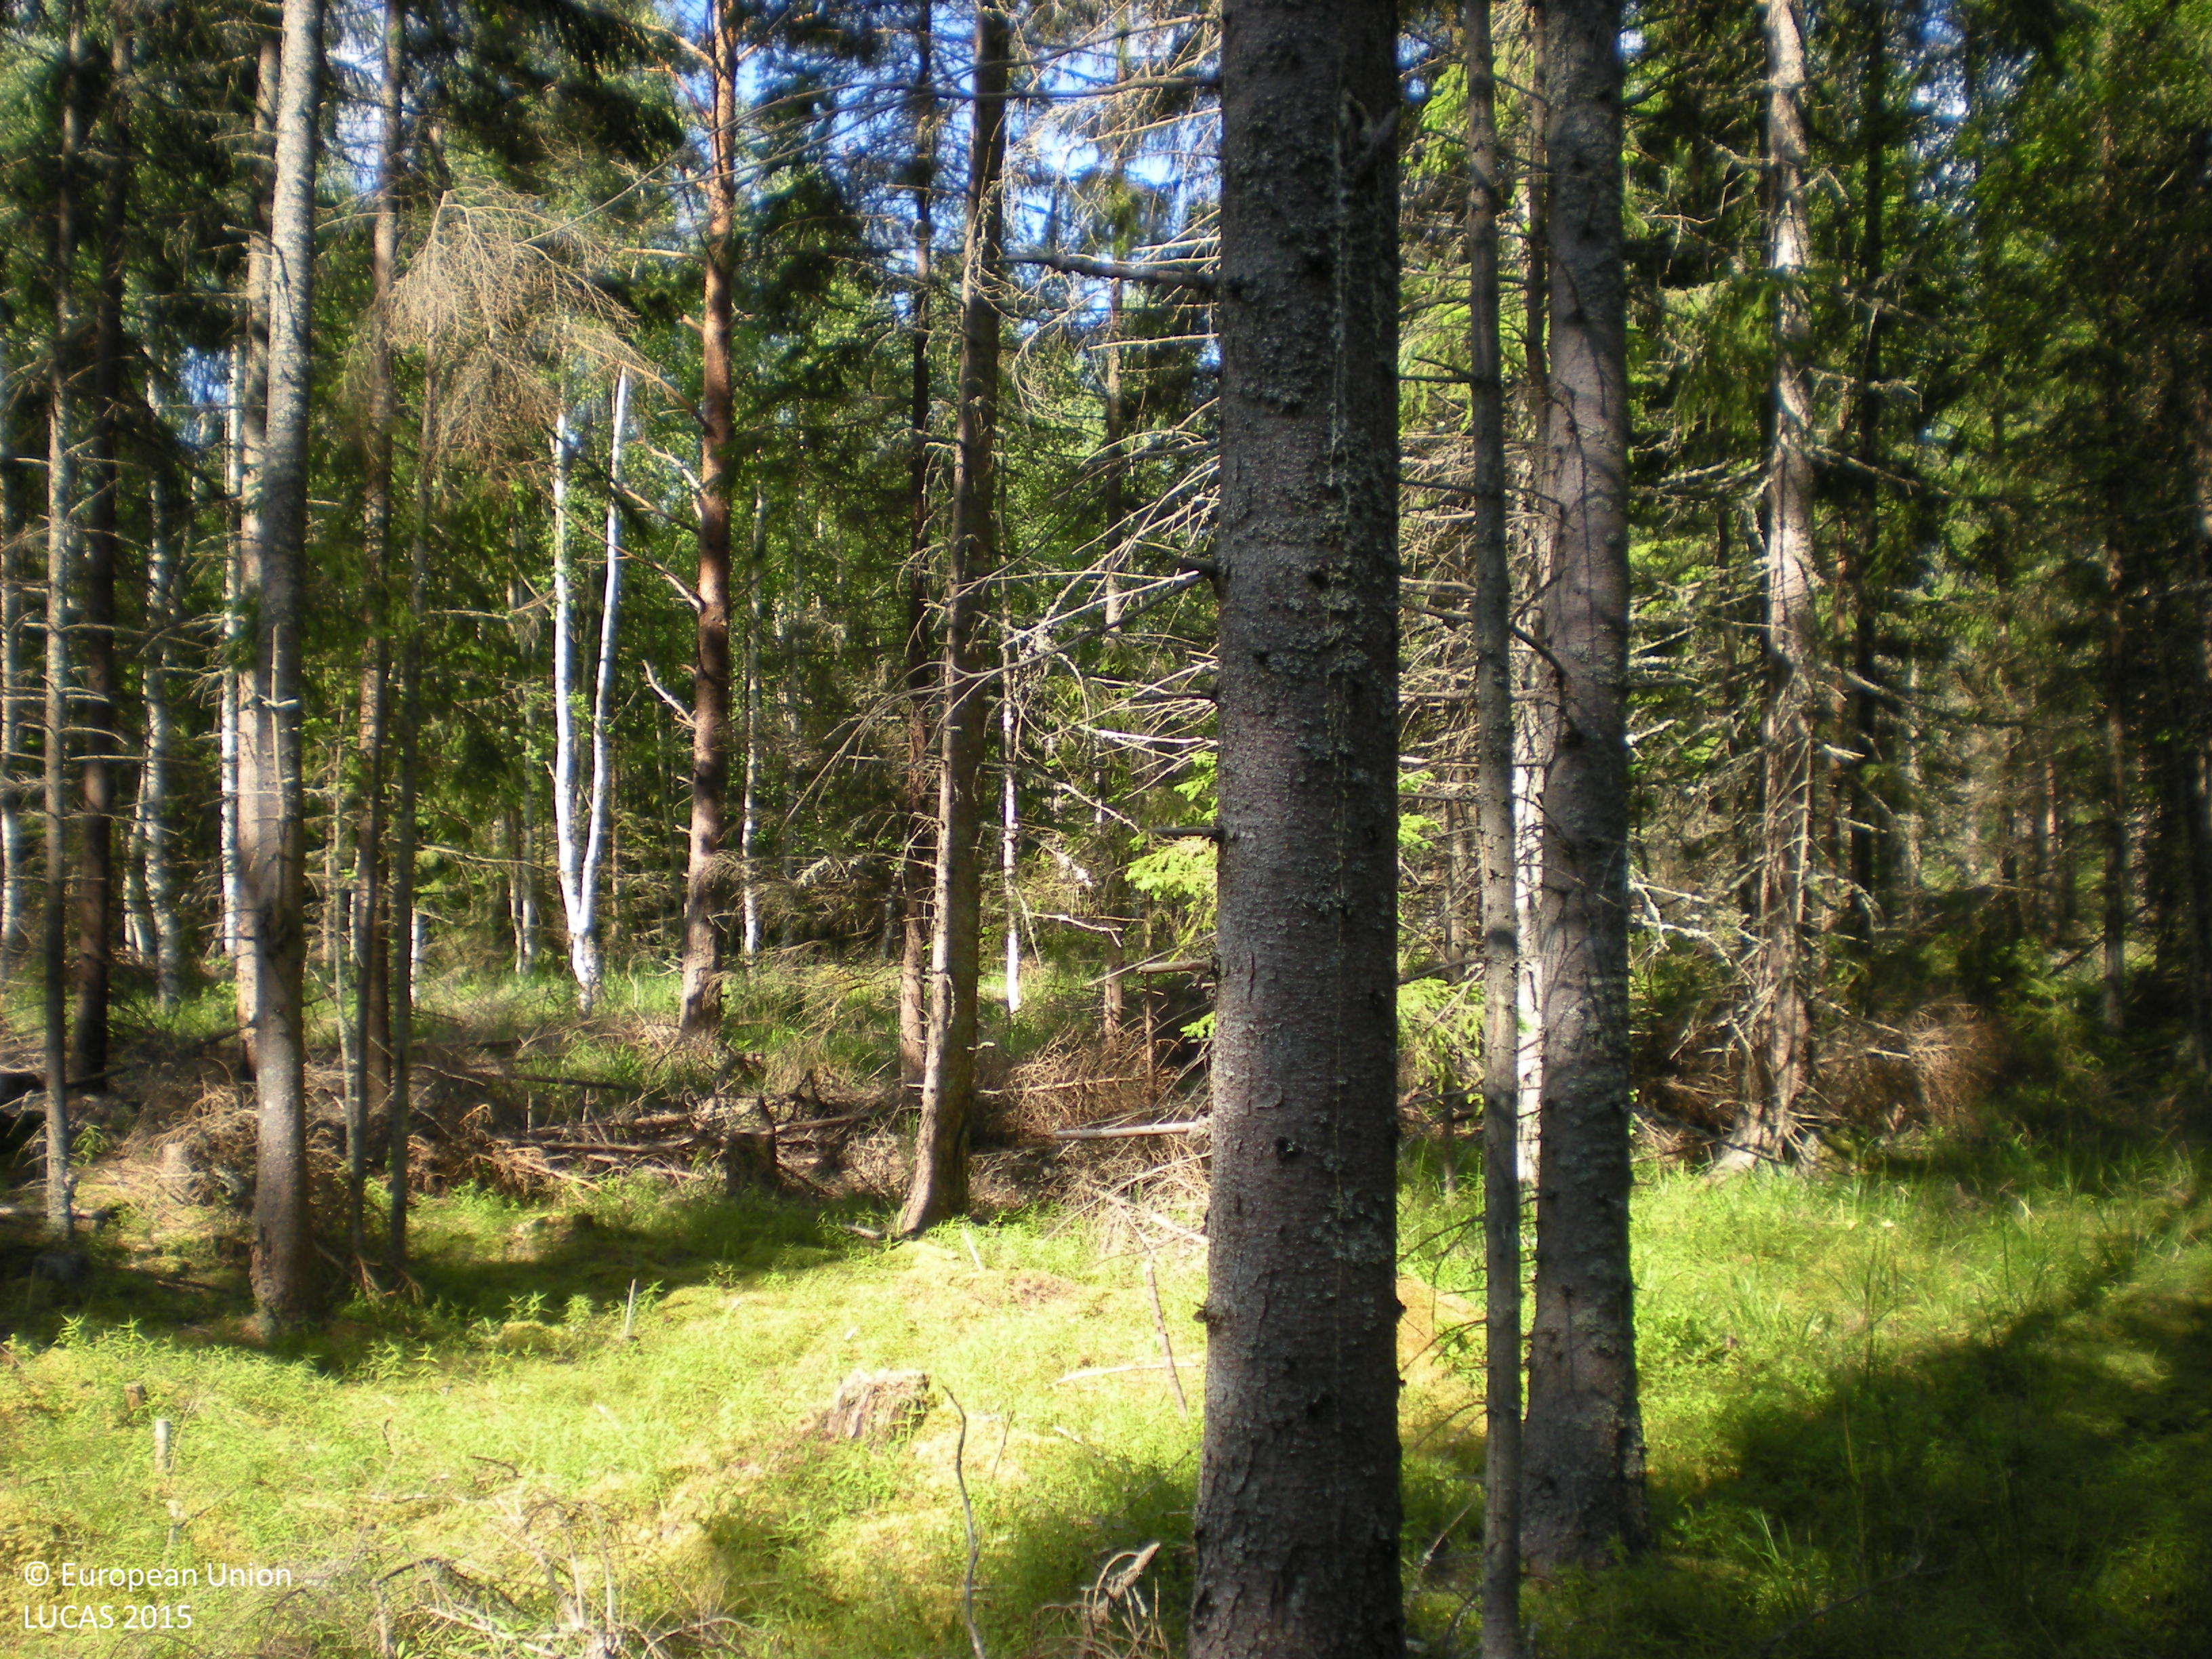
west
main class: Woodland
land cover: Spruce dominated coniferous woodland
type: boreal forest
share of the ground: 50 - 75 %
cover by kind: coniferous forest trees 65 %, shrubs 10 %, broadleaved forest trees 5 %, herbaceous plants 5 %, lichens and mosses 5 %, consolidated bare surface 5 %
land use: Forestry
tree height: > 5 m
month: June
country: SE
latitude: 60.4378
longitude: 18.0793
